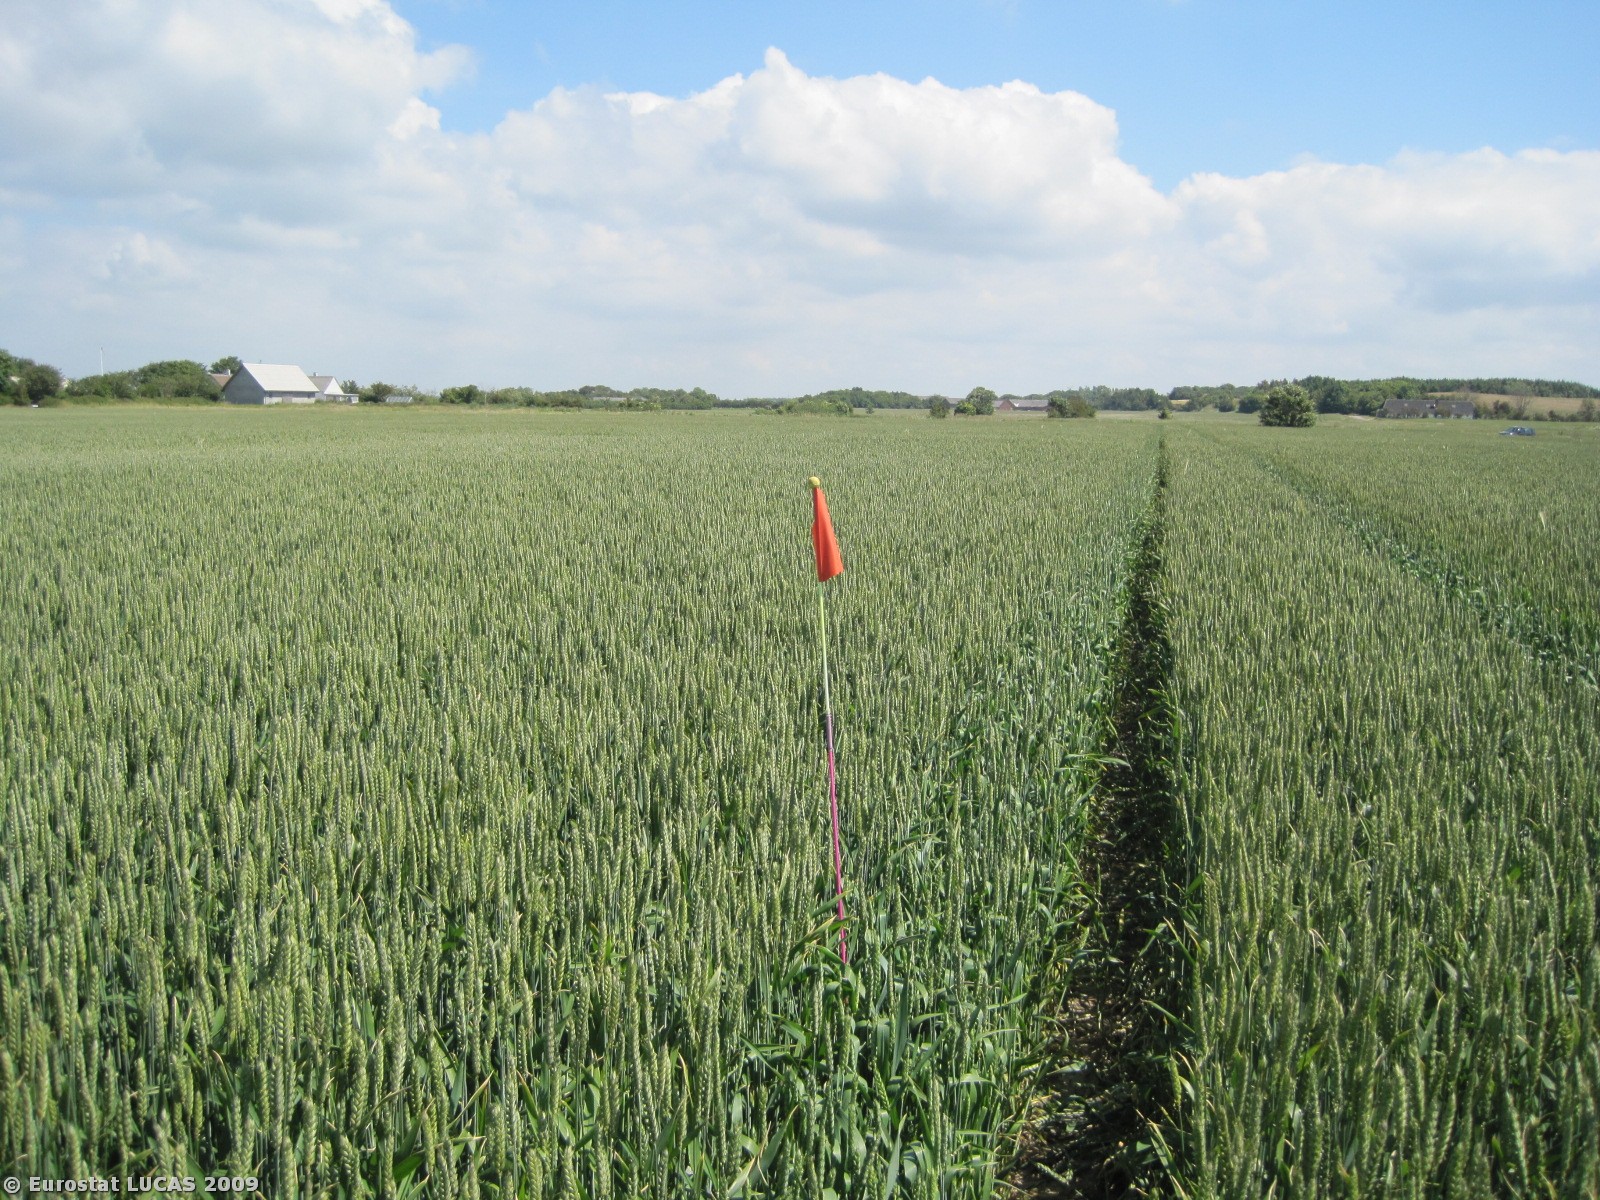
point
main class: Cropland
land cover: Common wheat
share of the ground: > 75 %
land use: Agriculture (excluding fallow land and kitchen gardens)
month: June
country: DK
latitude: 56.5415
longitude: 8.7818
